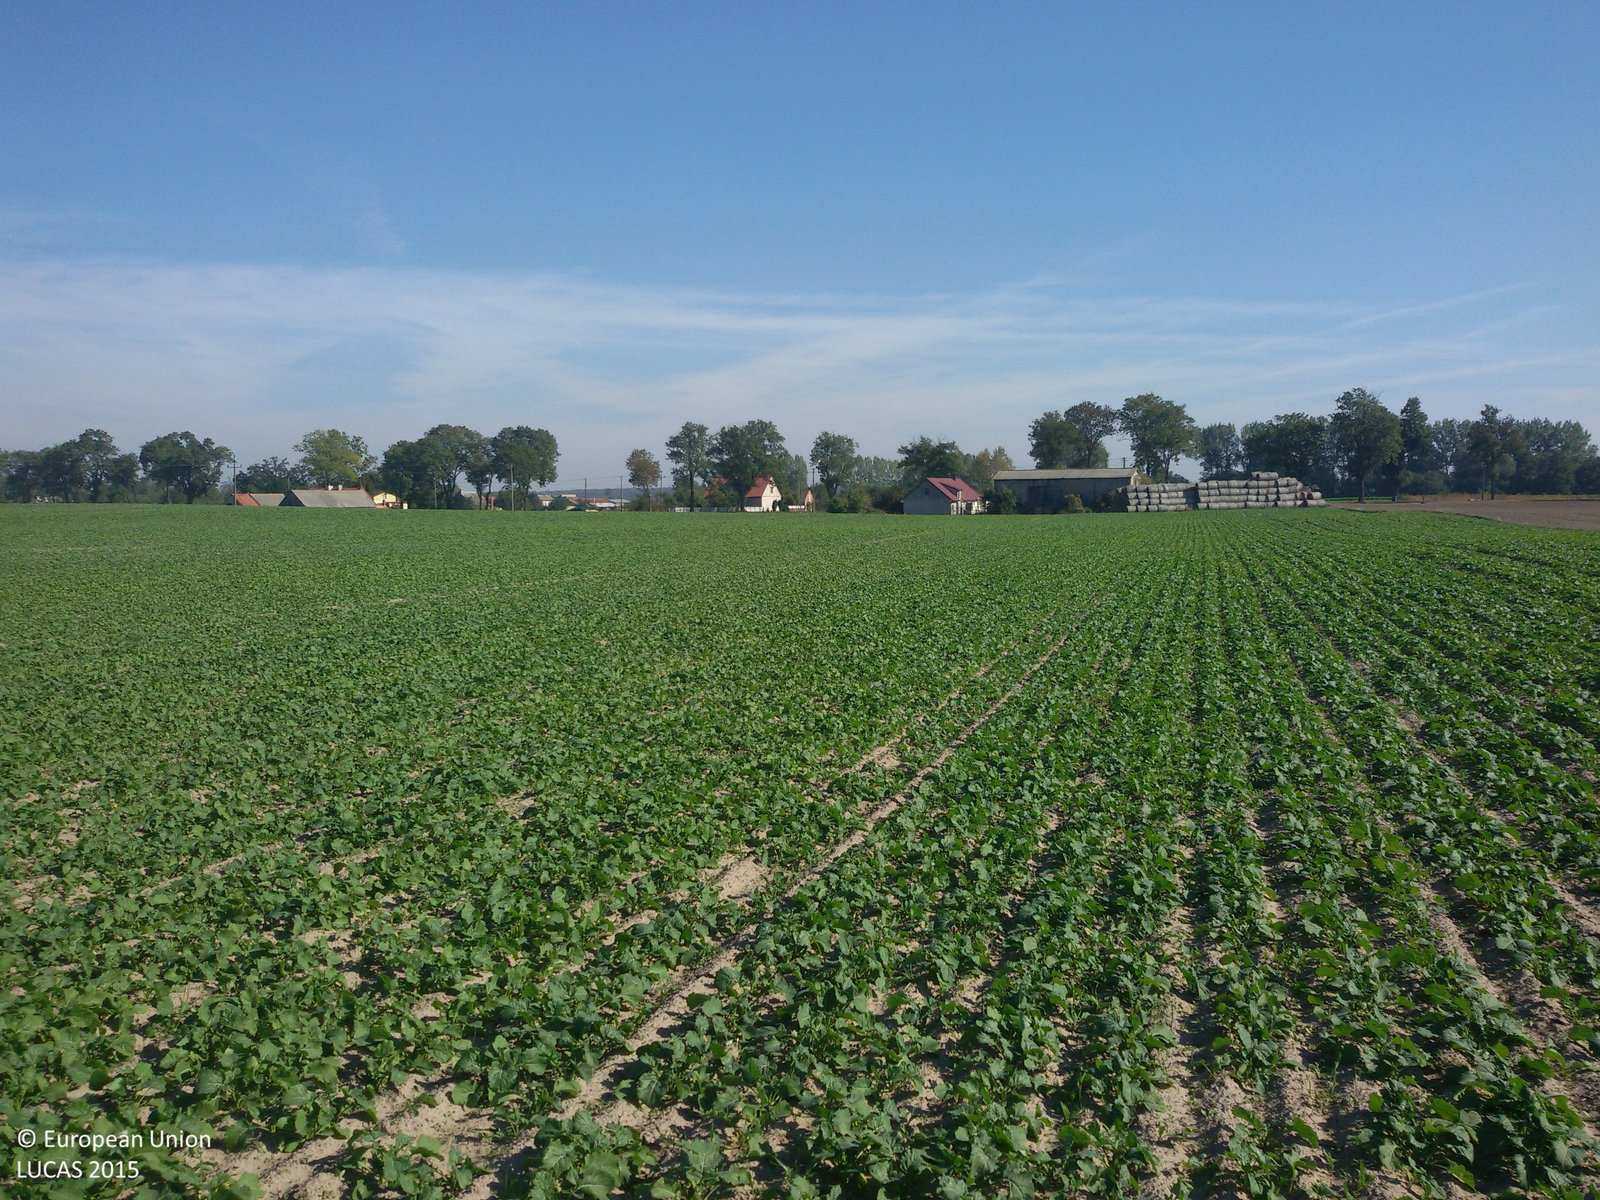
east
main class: Cropland
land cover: Rape and turnip rape
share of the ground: > 75 %
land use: Agriculture (excluding fallow land and kitchen gardens)
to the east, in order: Rape and turnip rape; Grassland without tree/shrub cover; Fences; Shrubland with sparse tree cover; Fences; Tracks; Rape and turnip rape
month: October
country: PL
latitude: 52.5751
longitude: 18.0282
